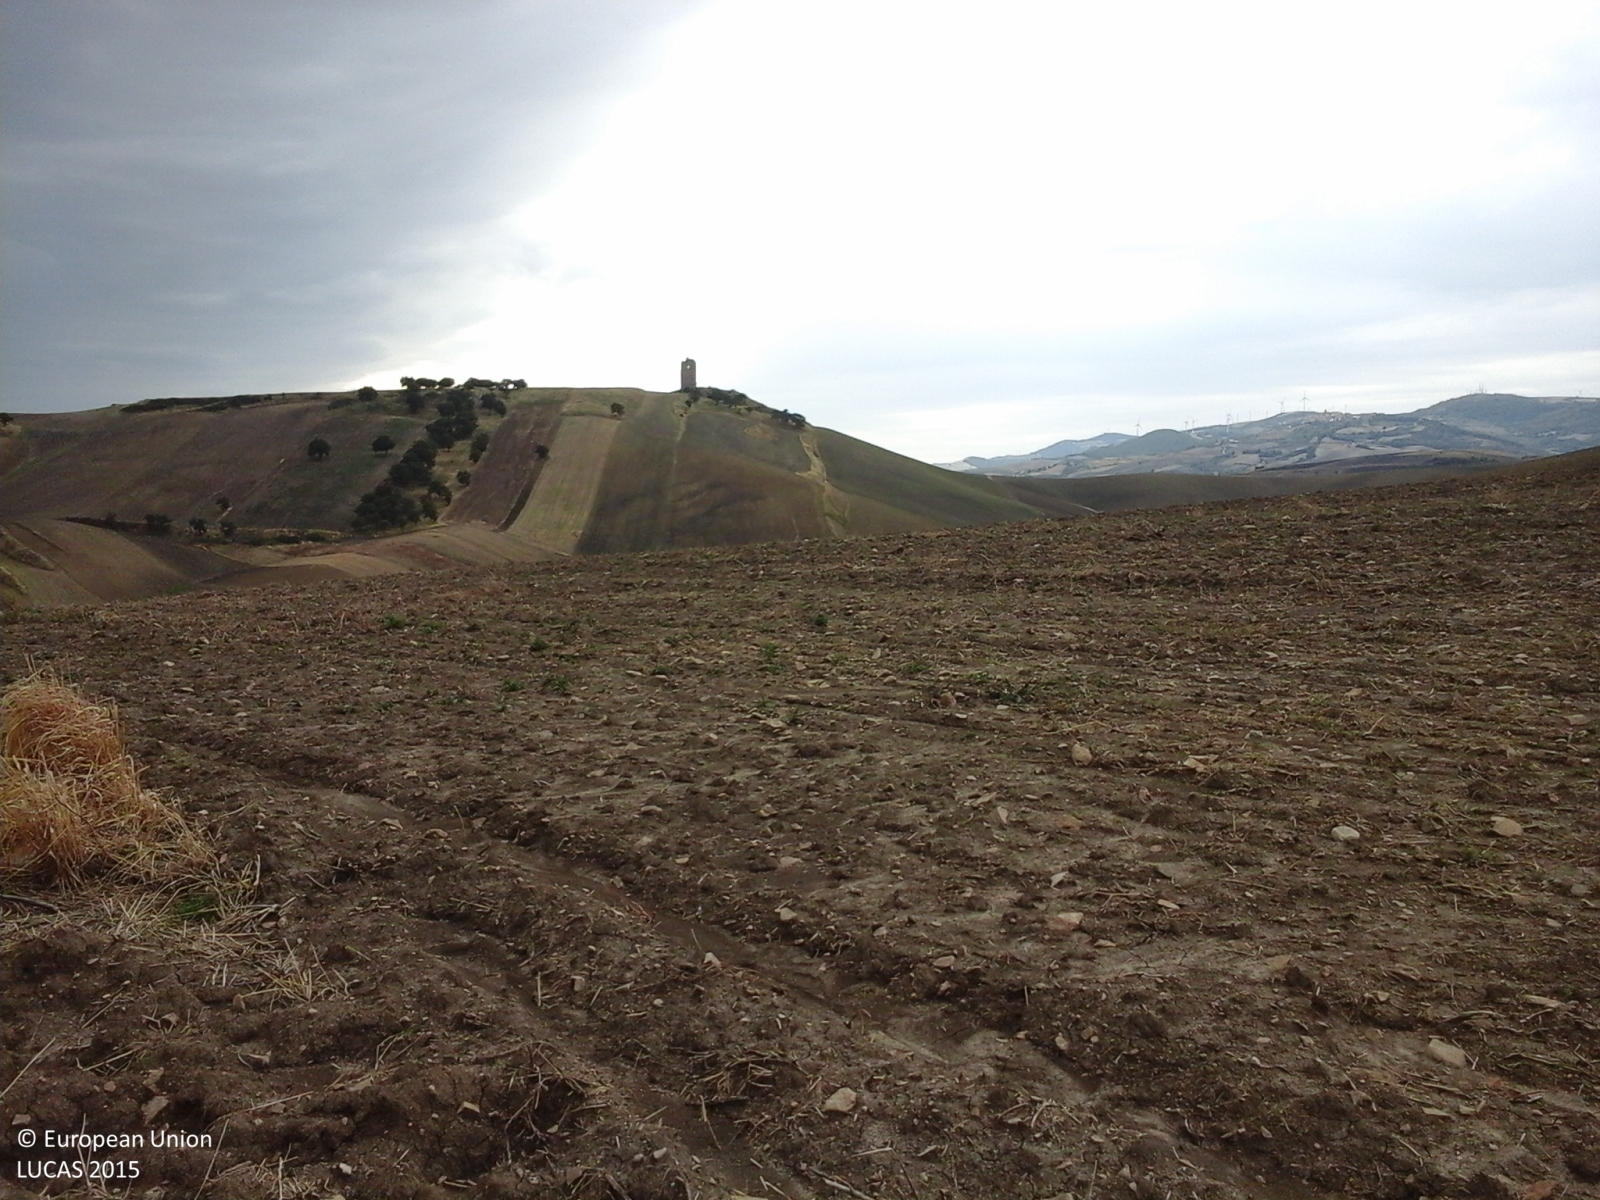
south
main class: Cropland
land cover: Durum wheat
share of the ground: > 75 %
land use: Agriculture (excluding fallow land and kitchen gardens)
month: October
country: IT
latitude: 41.5275
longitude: 15.1481
